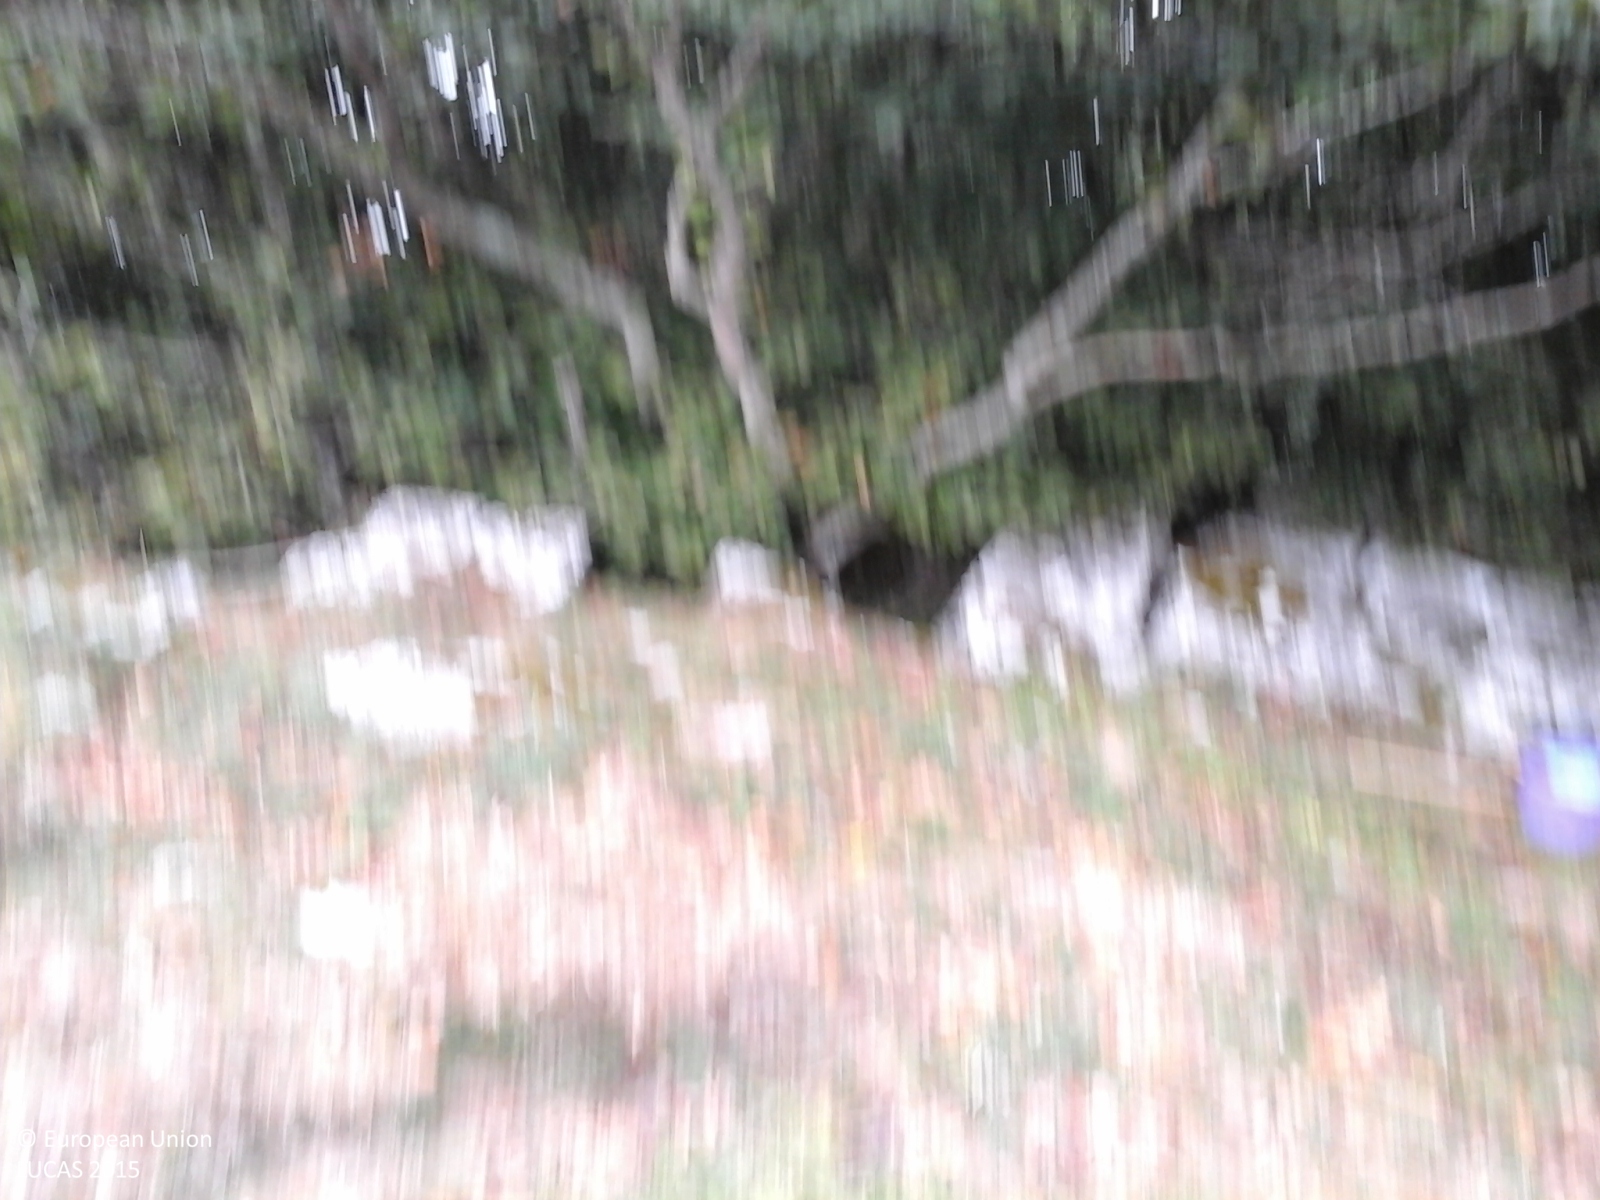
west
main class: Woodland
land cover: Broadleaved woodland
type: mountainous beech forest
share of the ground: > 75 %
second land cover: Grassland without tree/shrub cover
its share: > 75 %
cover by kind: broadleaved forest trees 70 %, shrubs 20 %, herbaceous plants 10 %
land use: Forestry
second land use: Agriculture (excluding fallow land and kitchen gardens)
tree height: > 5 m
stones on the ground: 25 - 50 %
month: September
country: IT
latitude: 41.6362
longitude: 14.3903
